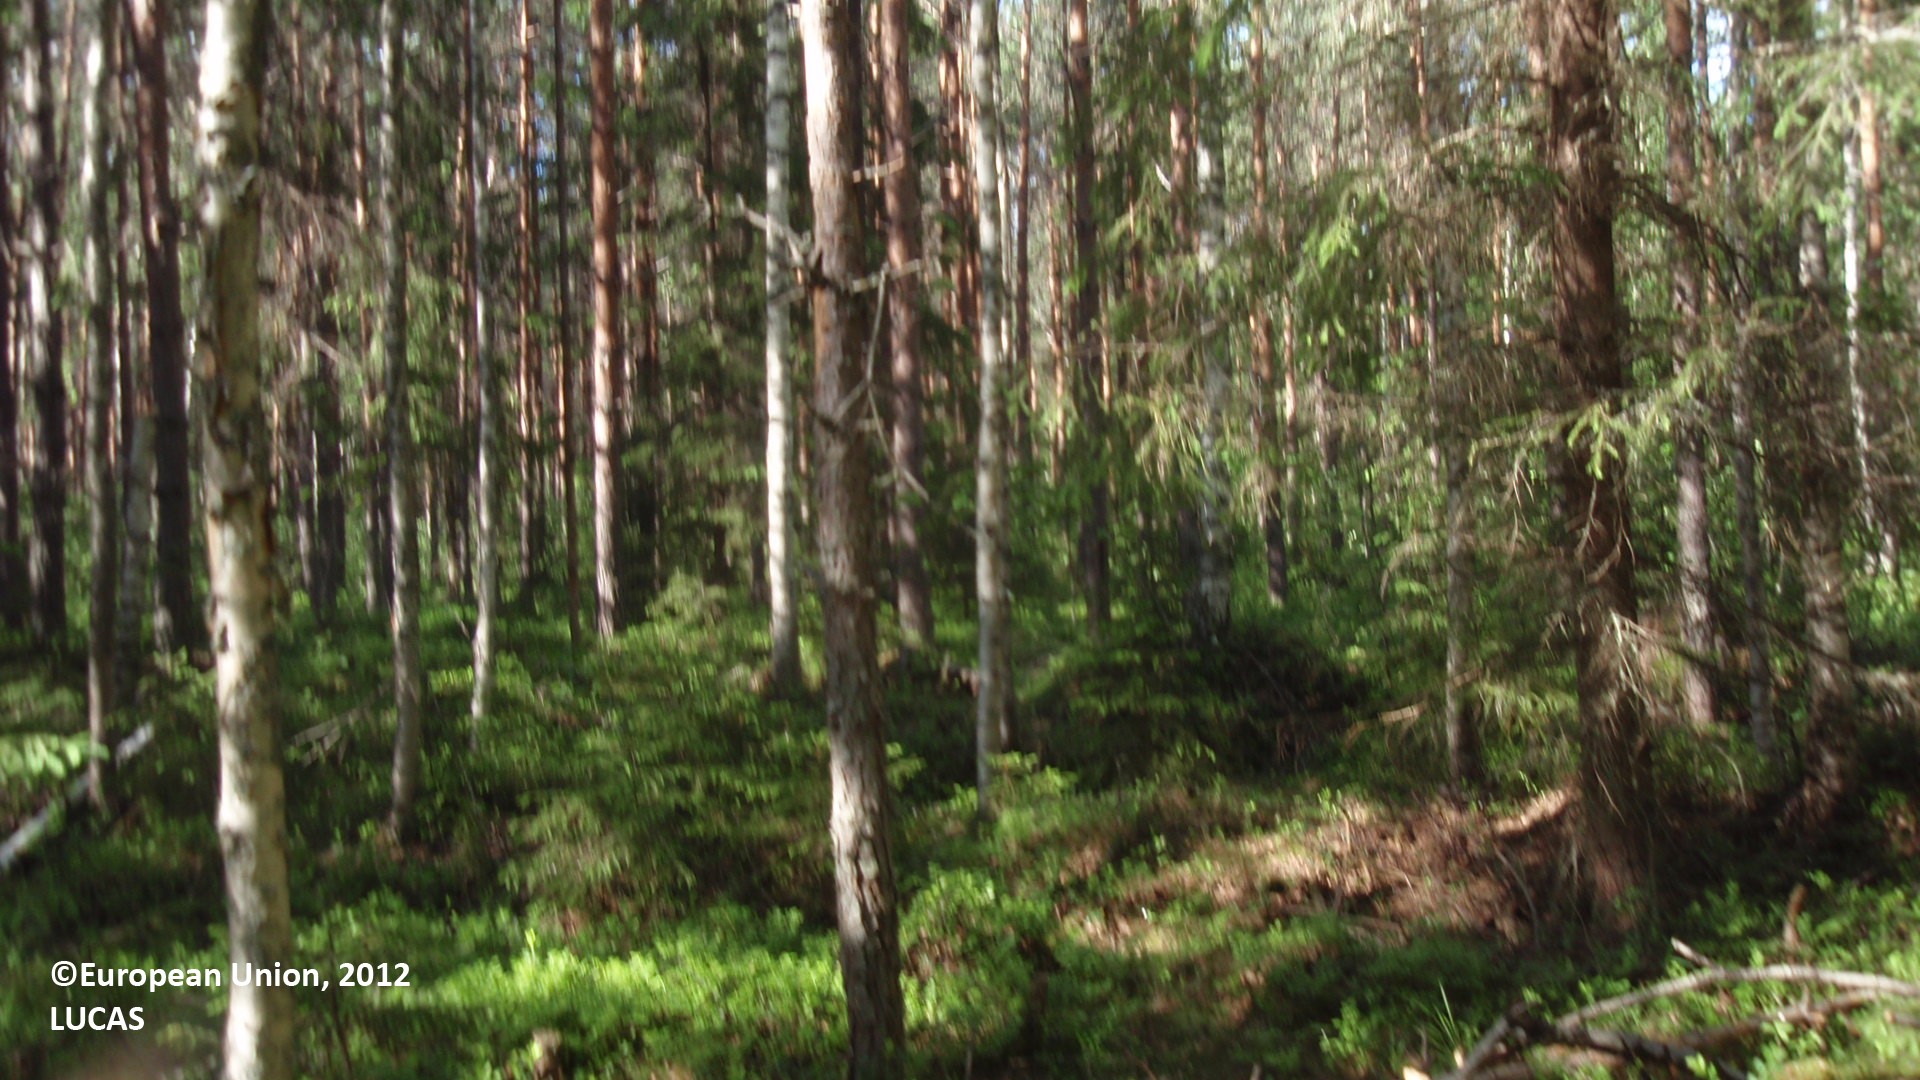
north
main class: Woodland
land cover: Spruce dominated mixed woodland
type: boreal forest
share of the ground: > 75 %
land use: Forestry
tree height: > 5 m
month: June
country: FI
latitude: 61.7416
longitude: 27.0305
